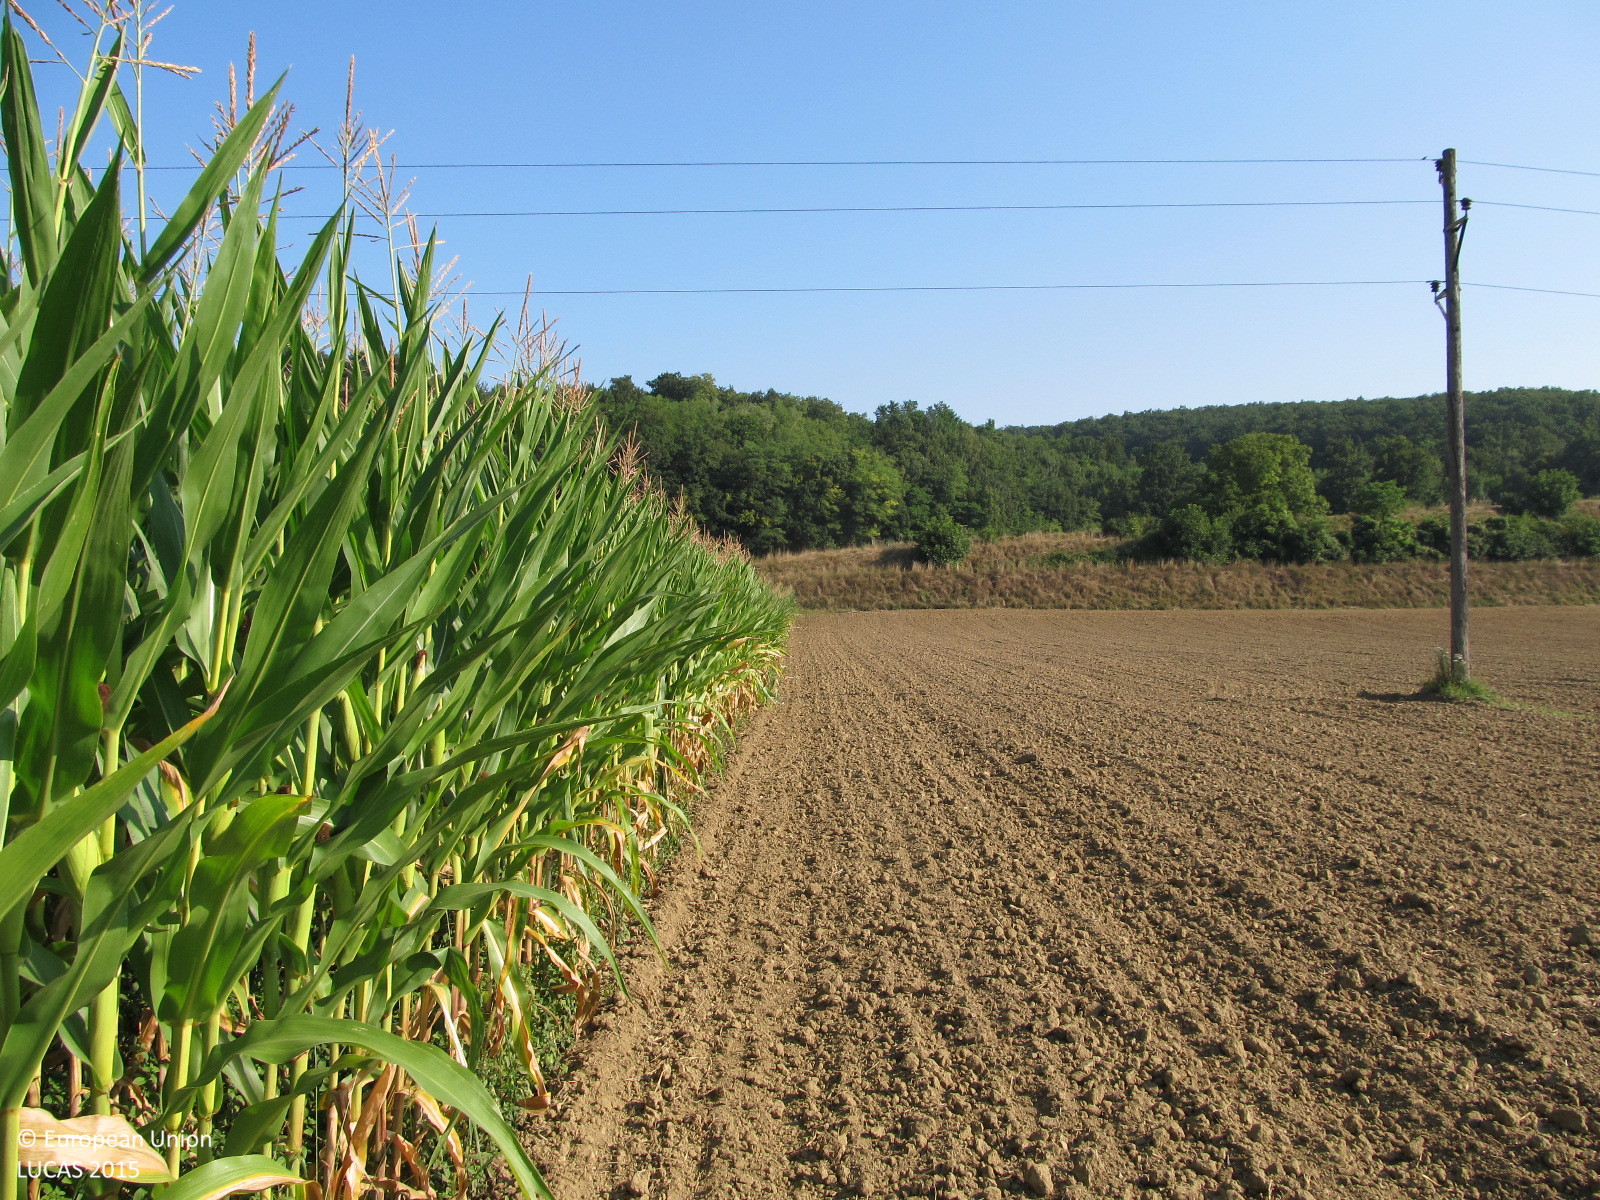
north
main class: Cropland
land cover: Maize
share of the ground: > 75 %
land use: Agriculture (excluding fallow land and kitchen gardens)
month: August
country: AT
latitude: 48.3032
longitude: 15.8410
